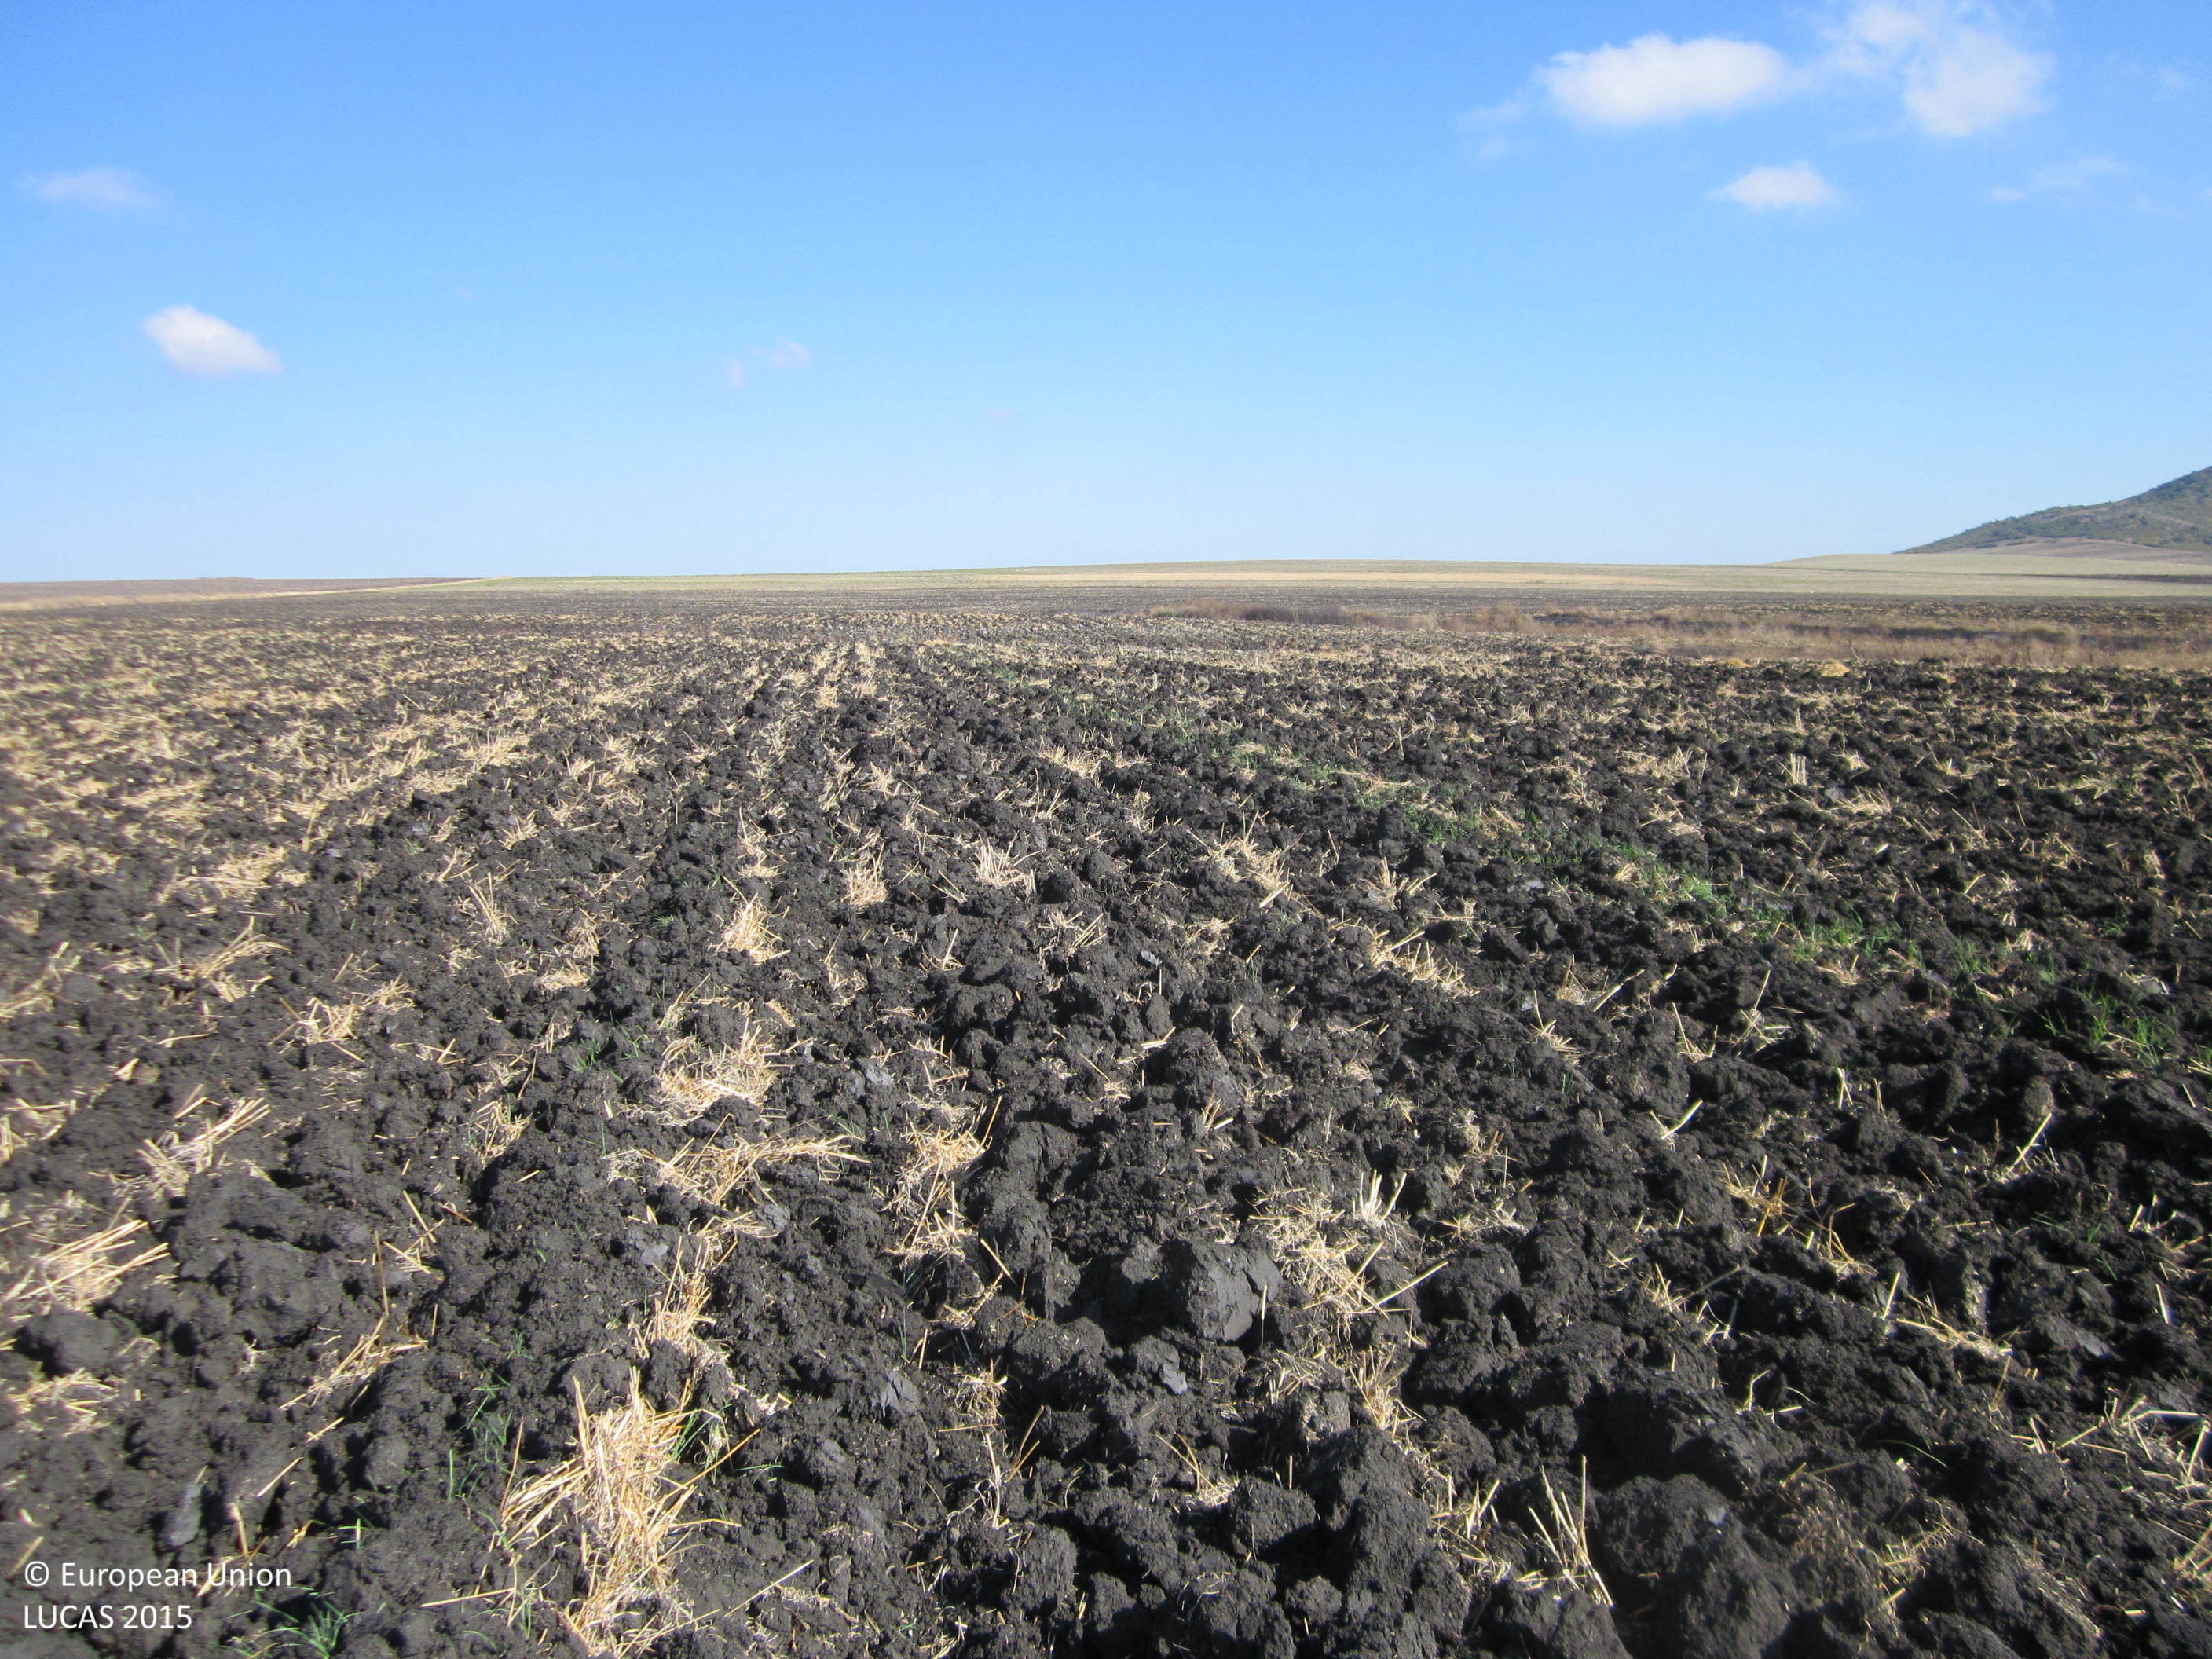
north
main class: Cropland
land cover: Oats
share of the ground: < 10 %
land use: Agriculture (excluding fallow land and kitchen gardens)
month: September
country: BG
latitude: 42.6178
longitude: 27.2414
